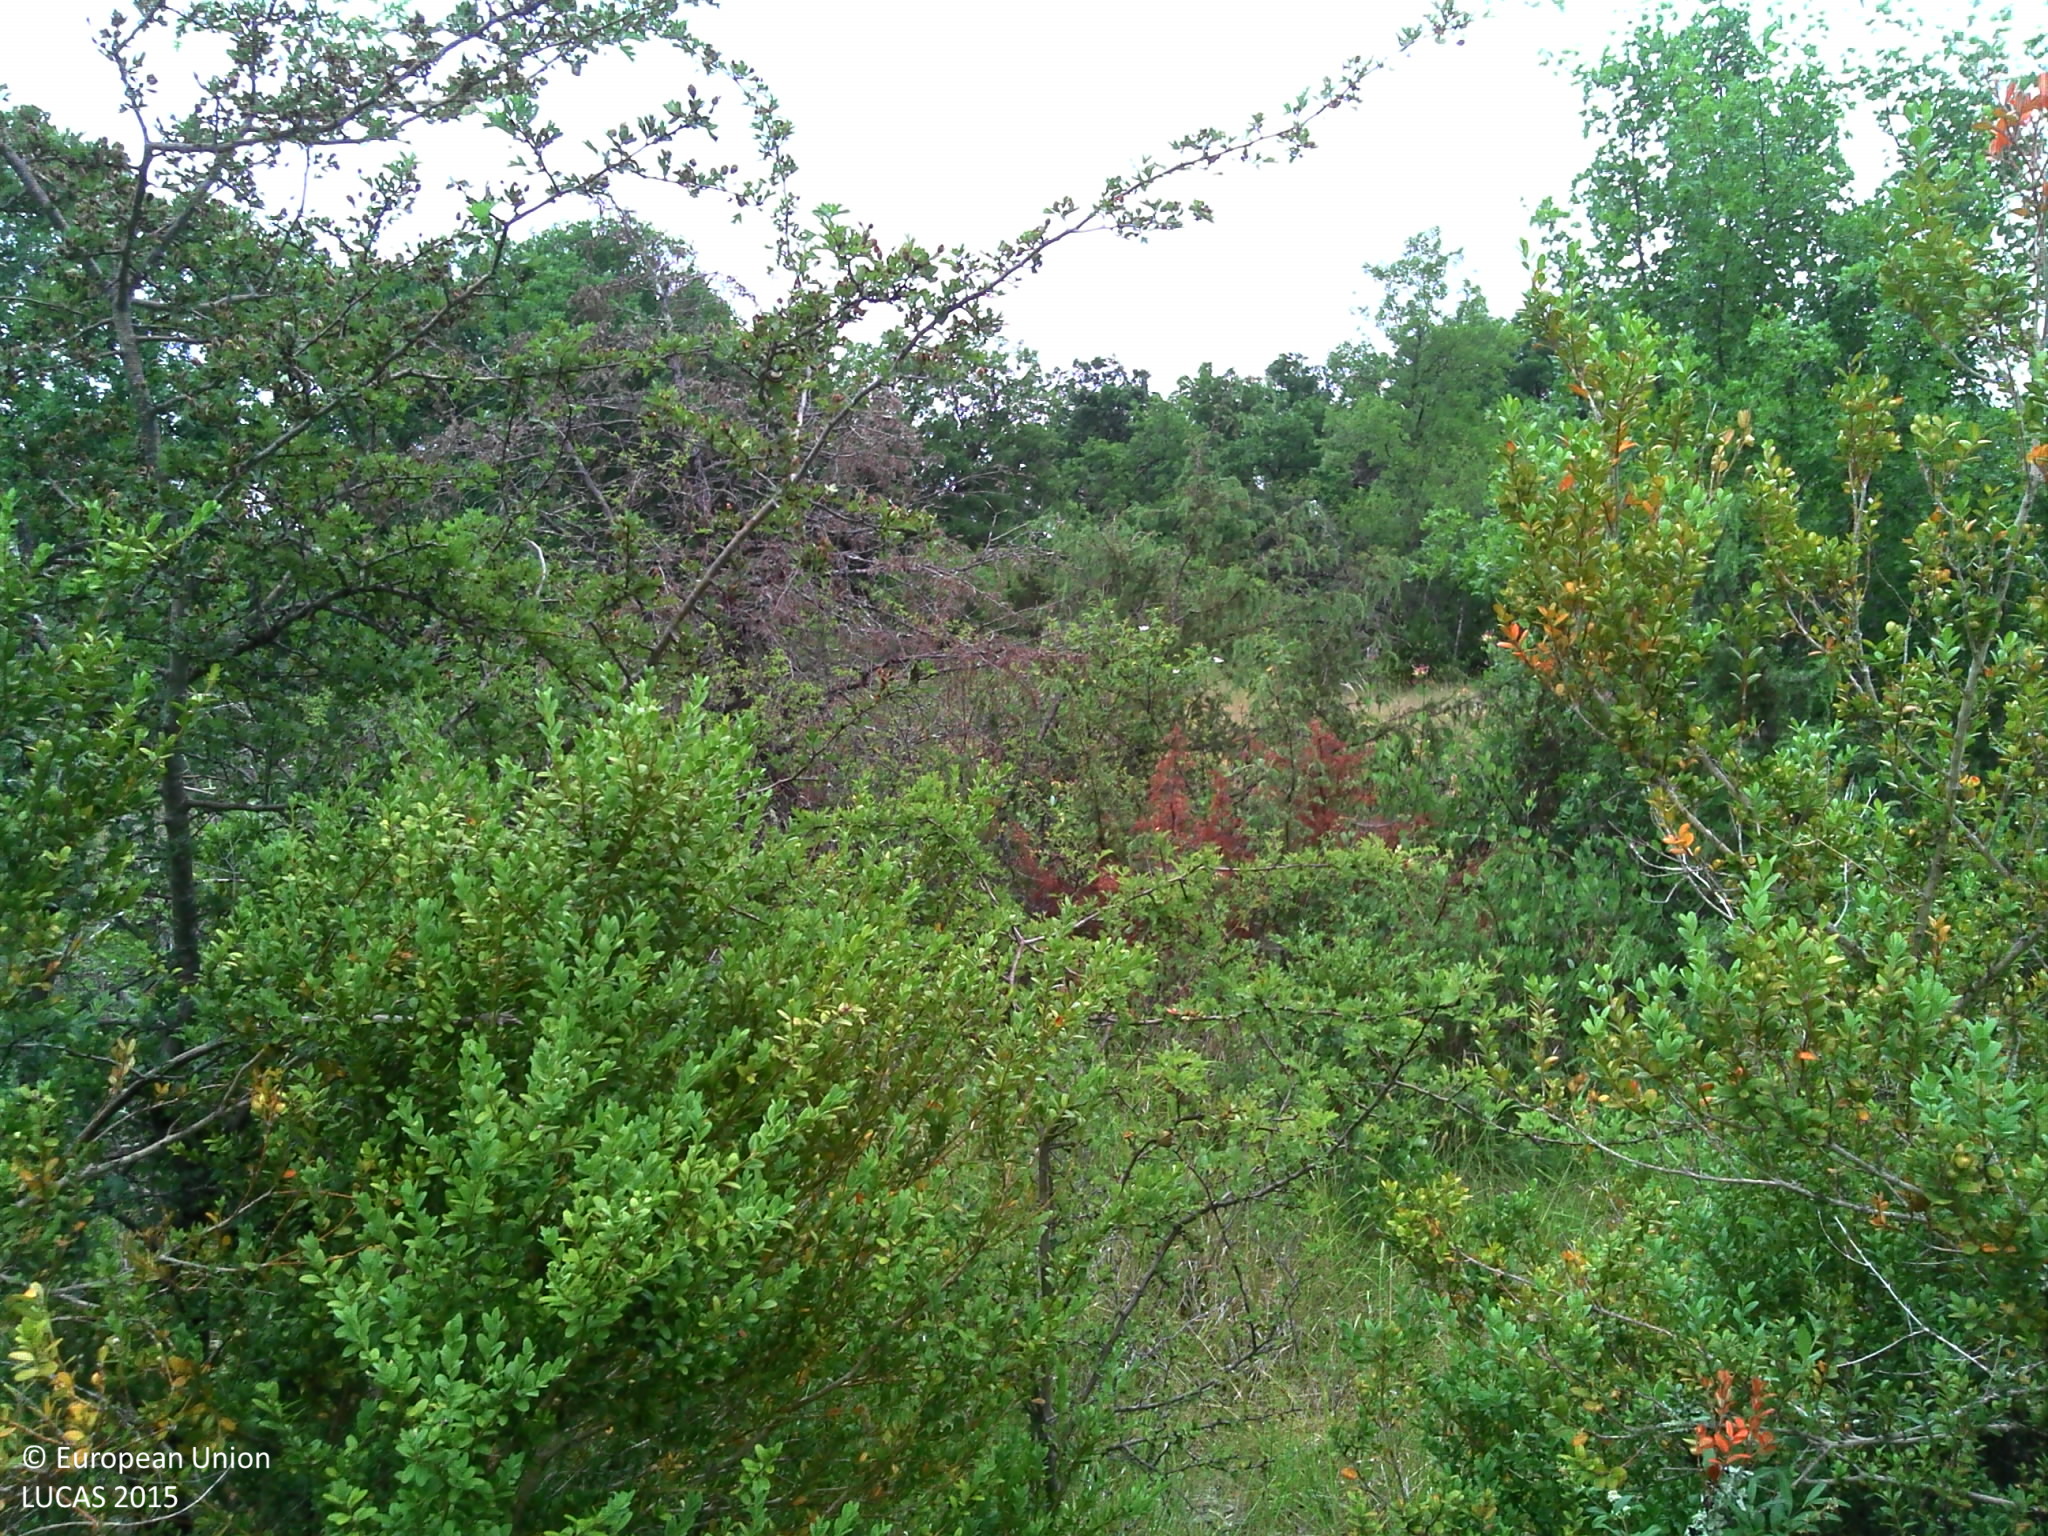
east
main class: Shrubland
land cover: Shrubland with sparse tree cover
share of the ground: > 75 %
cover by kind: shrubs 55 %, herbaceous plants 25 %, lichens and mosses 15 %, broadleaved forest trees 5 %
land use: Agriculture (excluding fallow land and kitchen gardens)
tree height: > 5 m
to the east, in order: Shrubland with sparse tree cover; Dry stone walls; Shrubland with sparse tree cover; Broadleaved woodland; Shrubland with sparse tree cover; Dry stone walls; Broadleaved woodland; Shrubland with sparse tree cover; Dry stone walls; Tracks; Abandoned hedges; Dry stone walls; Fences; Broadleaved woodland; Grassland with sparse tree/shrub cover
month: June
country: FR
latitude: 44.4678
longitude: 1.8926
